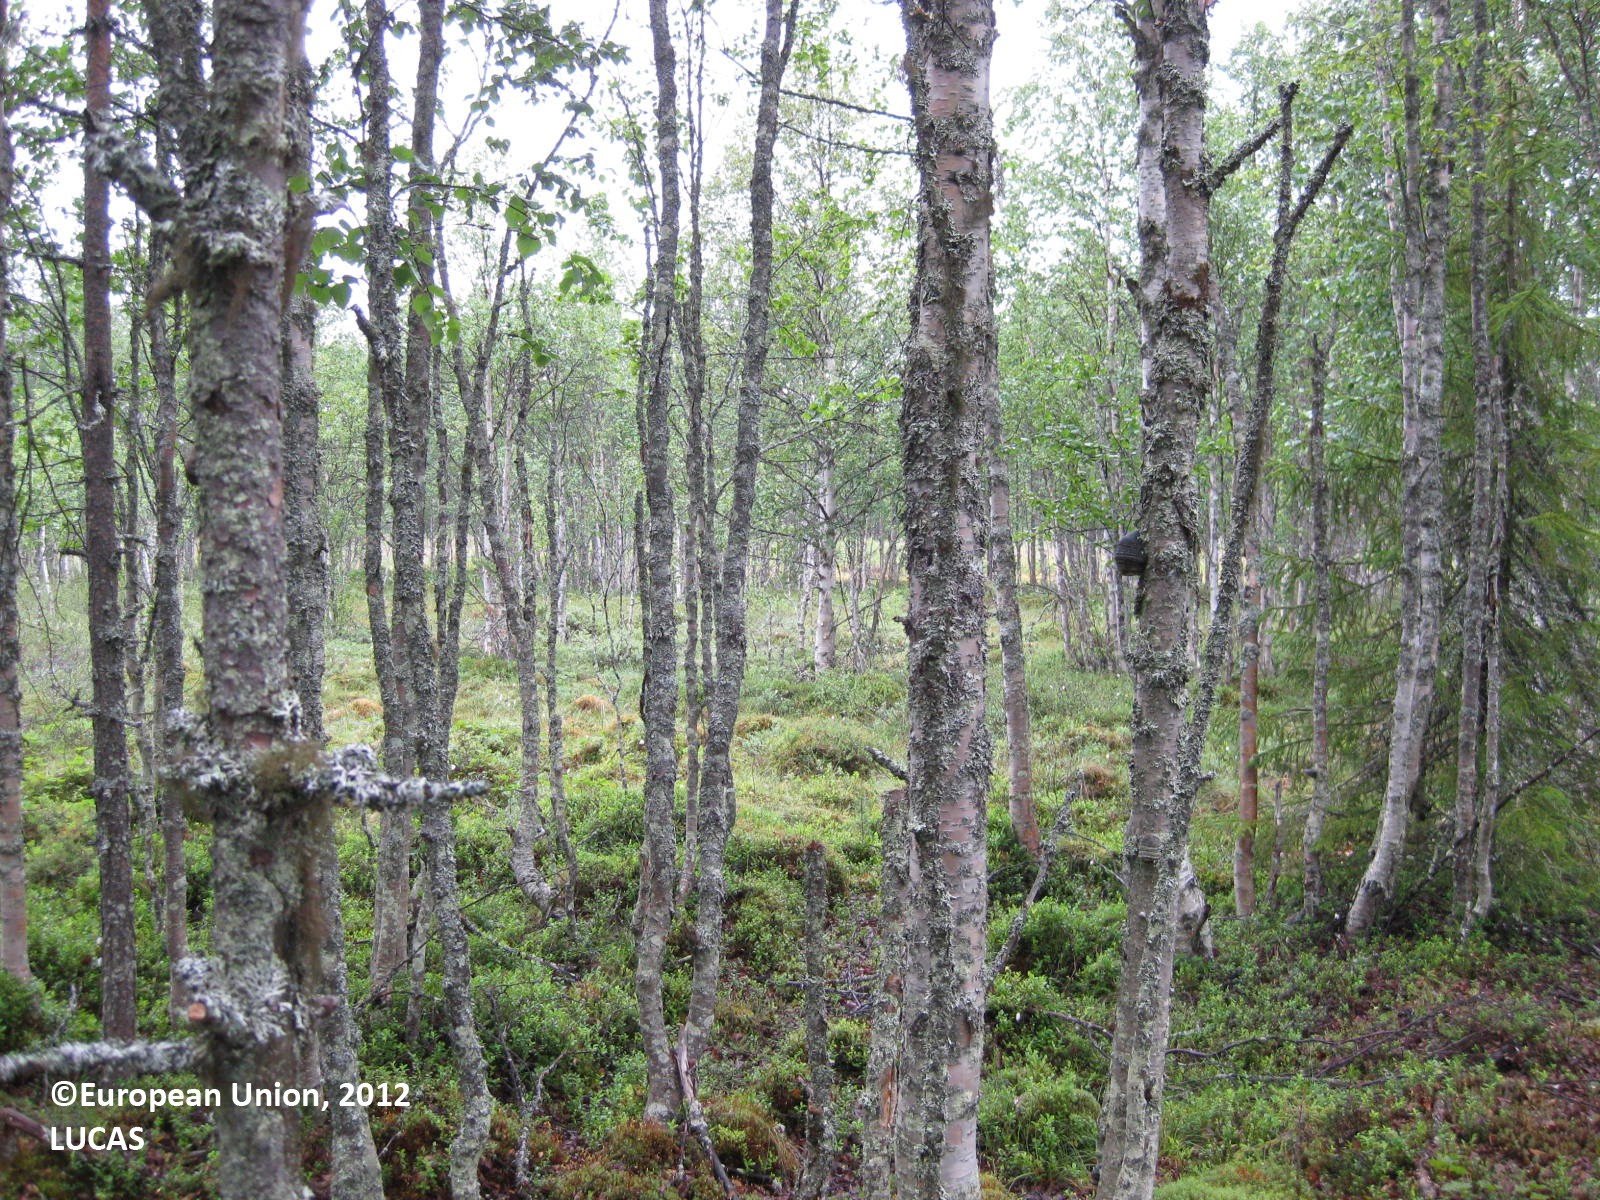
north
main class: Woodland
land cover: Broadleaved woodland
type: boreal forest
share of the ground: > 75 %
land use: Forestry
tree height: > 5 m
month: July
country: FI
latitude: 65.8140
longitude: 29.9644
